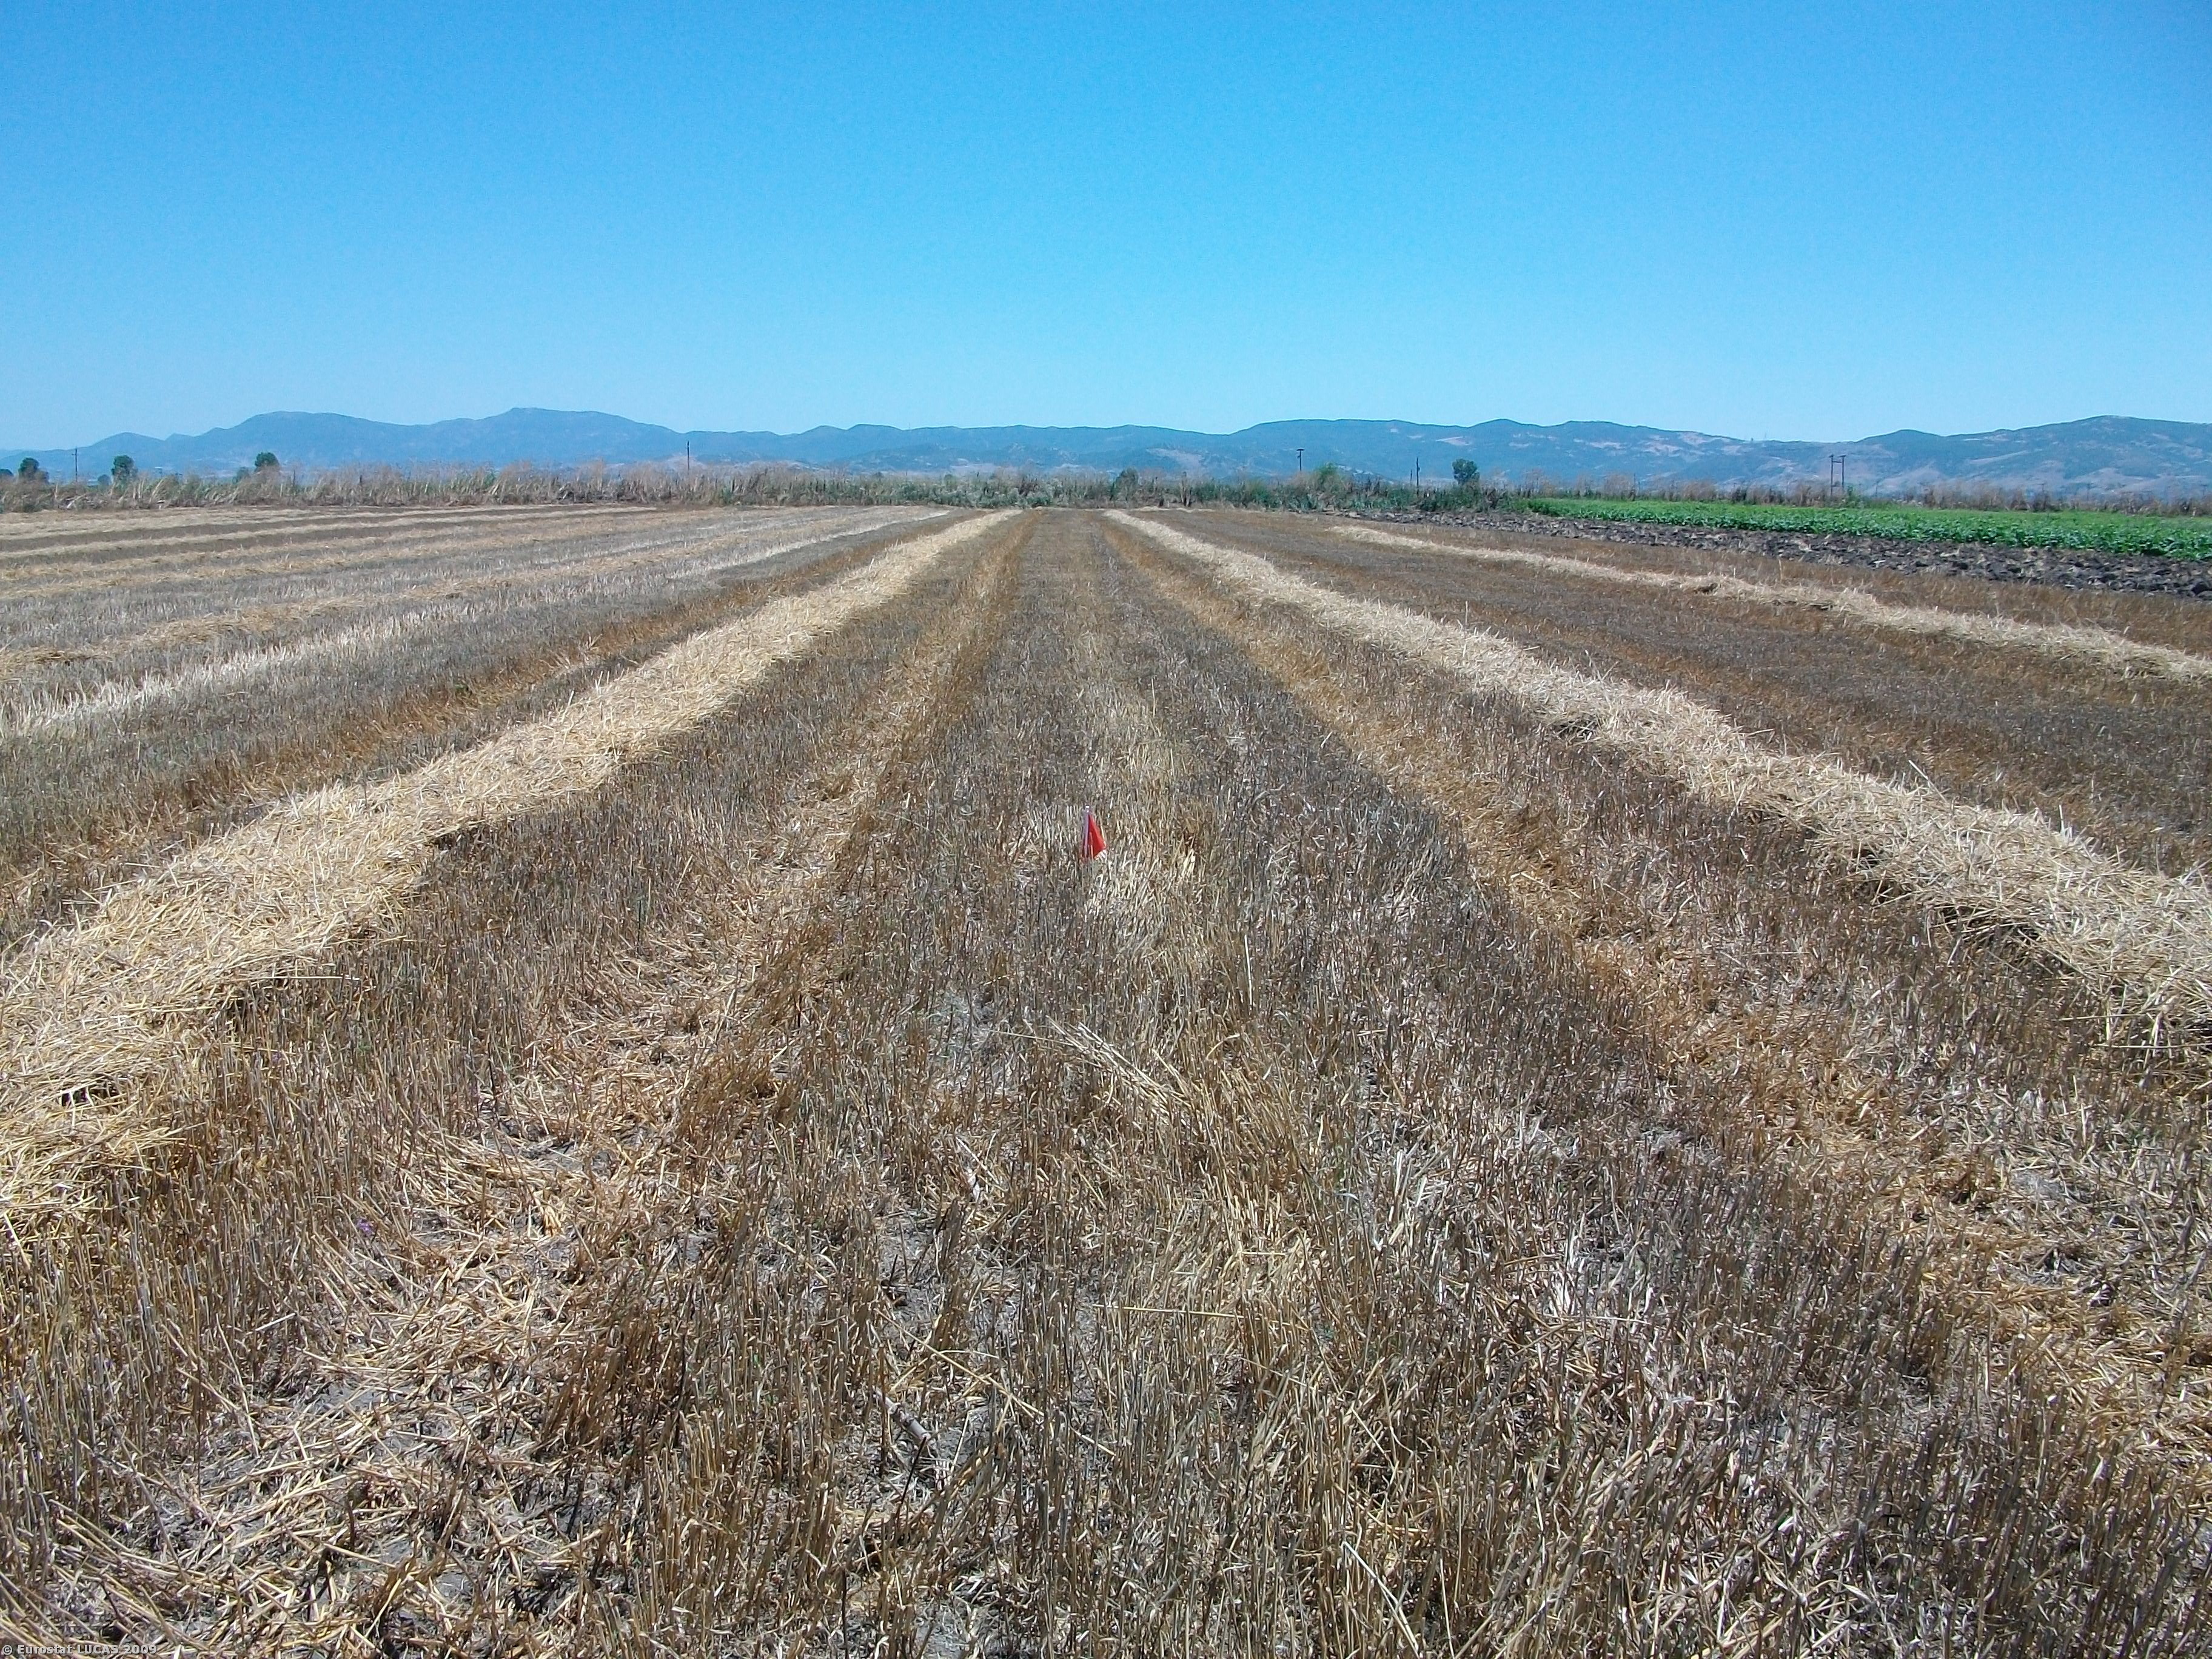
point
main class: Cropland
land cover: Durum wheat
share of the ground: > 75 %
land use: Agriculture (excluding fallow land and kitchen gardens)
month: July
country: GR
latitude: 39.0795
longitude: 22.2229
